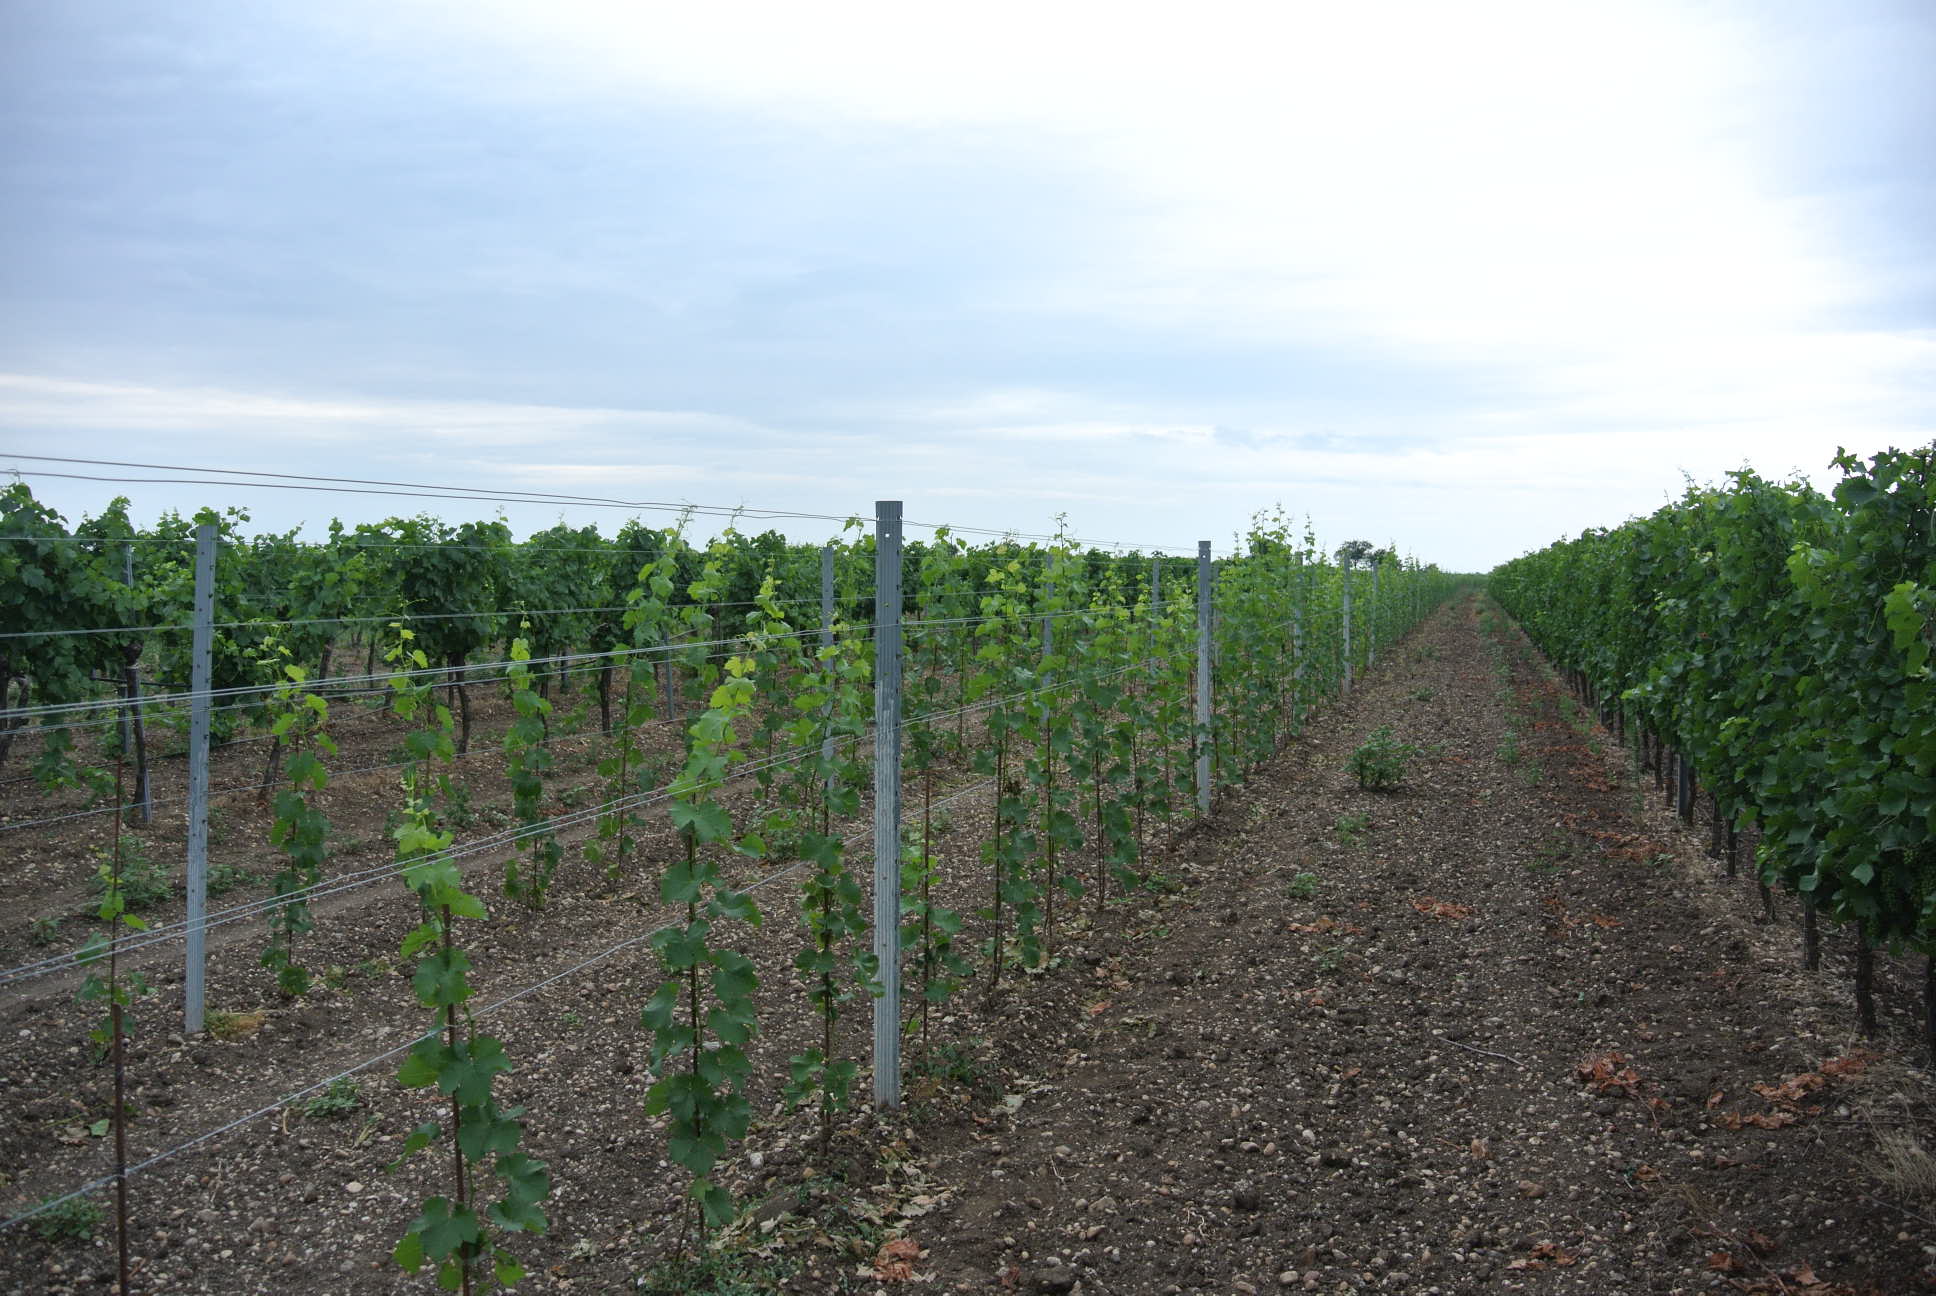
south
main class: Cropland
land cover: Vineyards
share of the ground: 25 - 50 %
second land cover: Other bare soil
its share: > 75 %
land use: Agriculture (excluding fallow land and kitchen gardens)
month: July
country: AT
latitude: 47.8813
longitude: 16.8929
